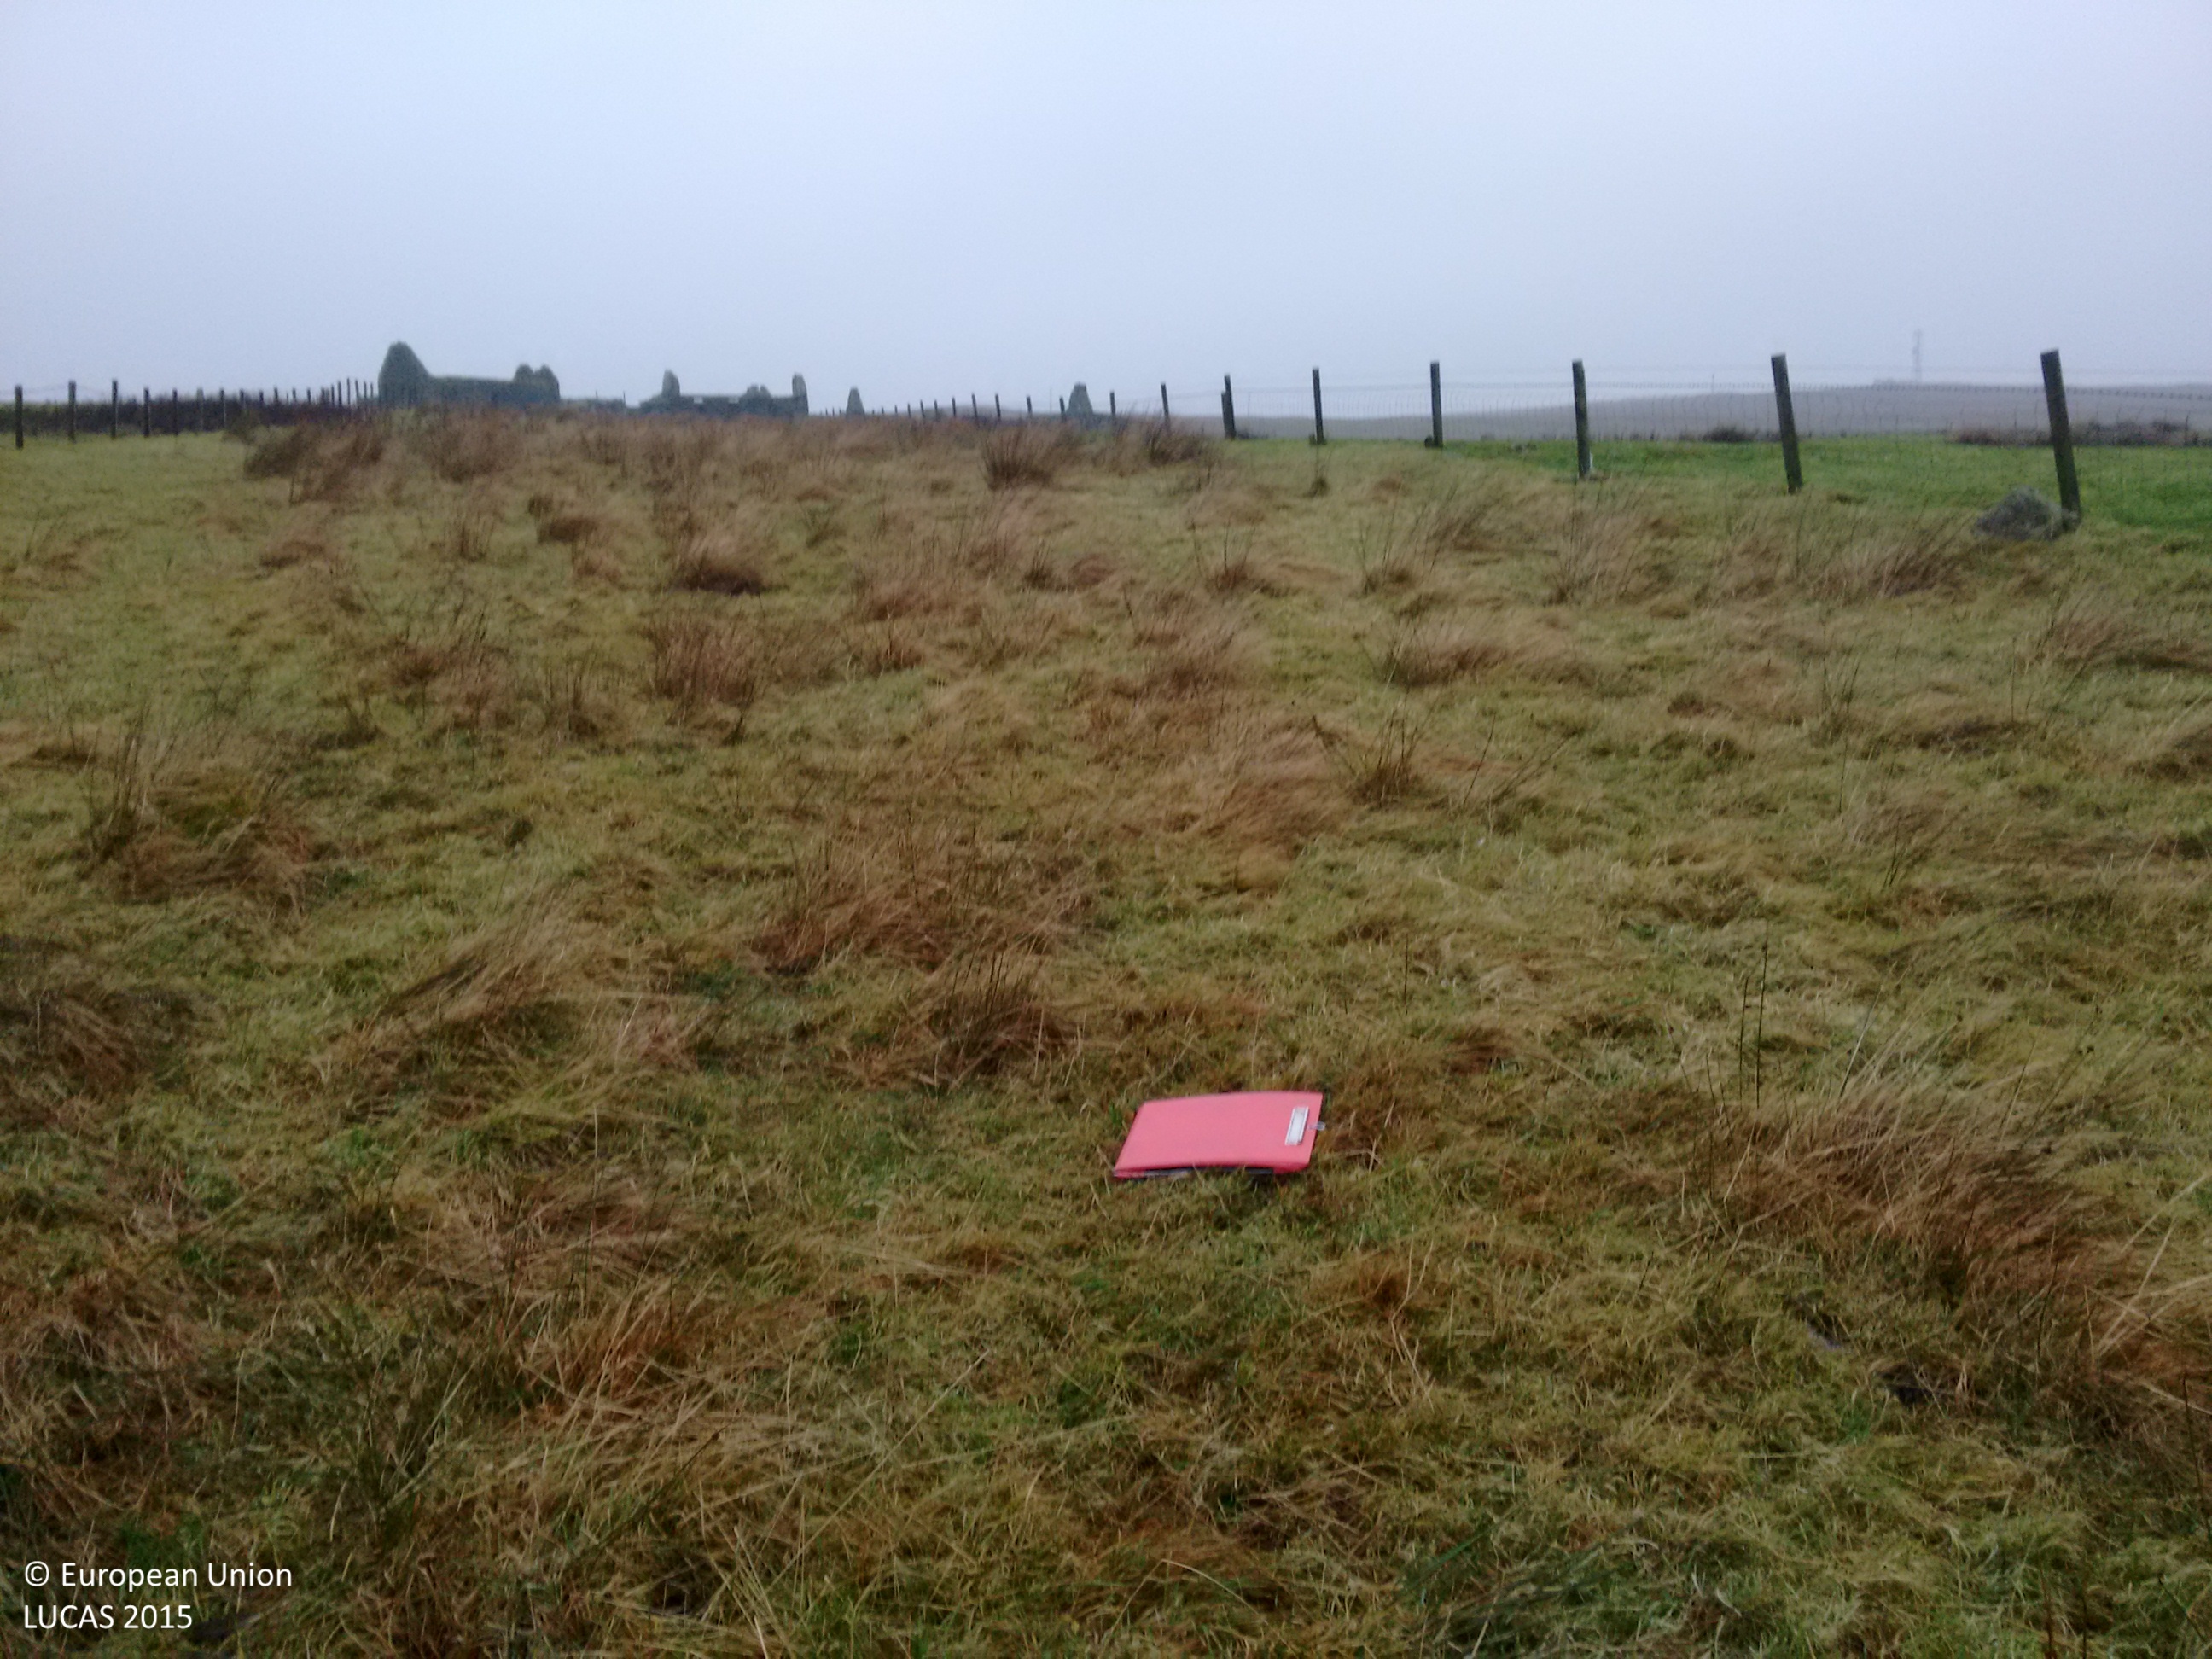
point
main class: Grassland
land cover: Grassland without tree/shrub cover
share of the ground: > 75 %
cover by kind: herbaceous plants 100 %
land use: Agriculture (excluding fallow land and kitchen gardens)
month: November
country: GB
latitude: 60.4793
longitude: -1.2062
